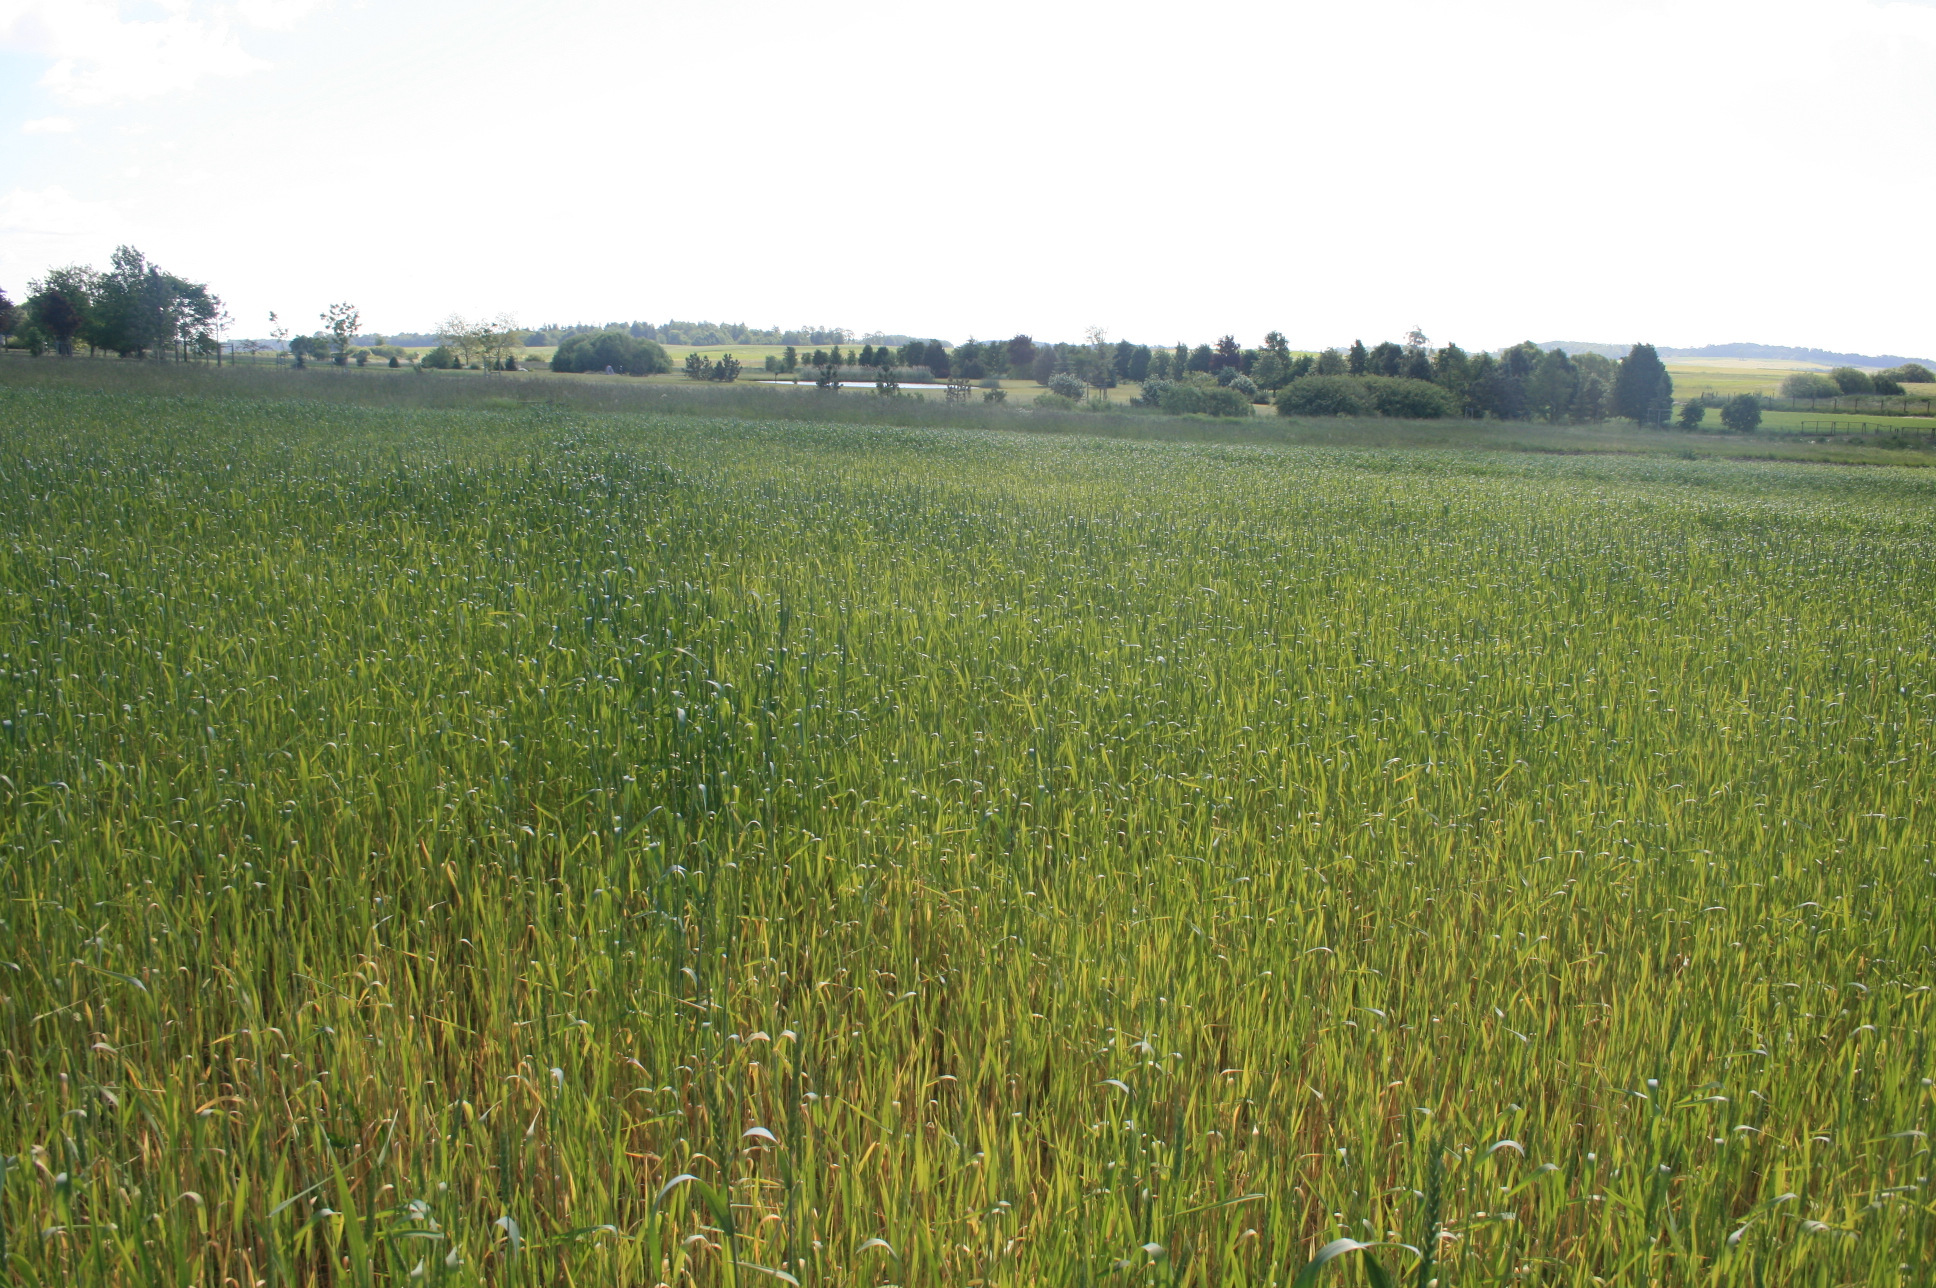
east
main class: Cropland
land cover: Common wheat
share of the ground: > 75 %
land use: Agriculture (excluding fallow land and kitchen gardens)
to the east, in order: Common wheat; Grassland without tree/shrub cover; Paved roads, cycling and walking lanes; Grass margins; Managed hedges; Grassland with sparse tree/shrub cover; Grassland without tree/shrub cover; Grassland with sparse tree/shrub cover; Inland fresh water bodies; Grassland without tree/shrub cover
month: June
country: LT
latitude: 55.9566
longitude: 22.3091
